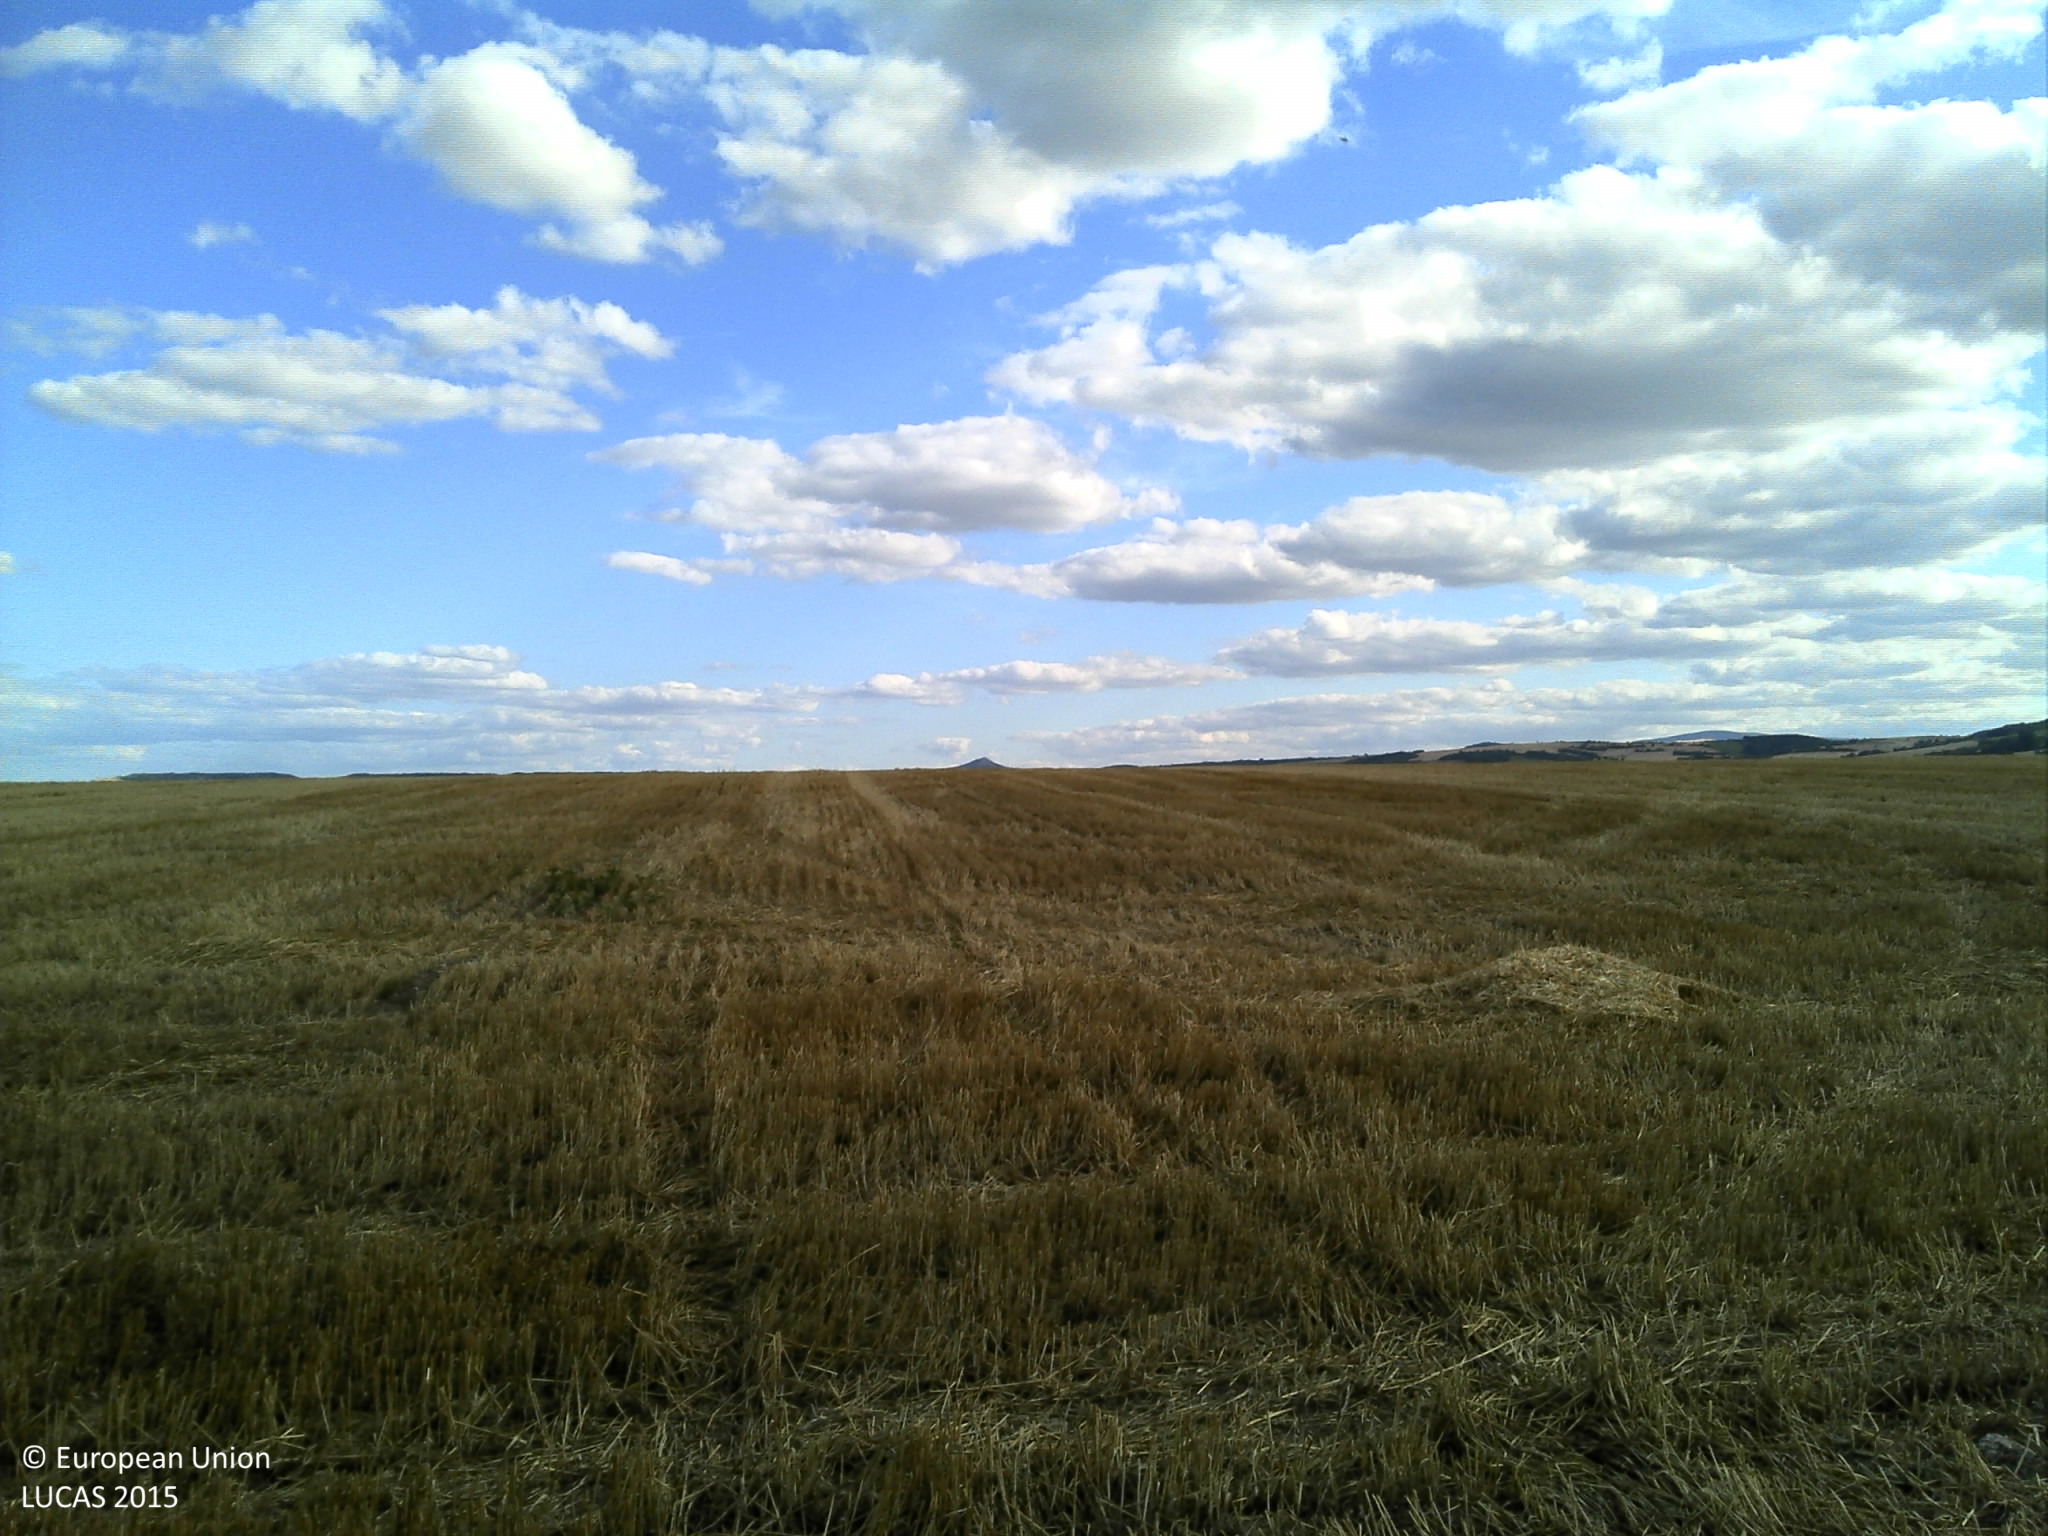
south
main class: Cropland
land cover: Common wheat
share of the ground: > 75 %
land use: Agriculture (excluding fallow land and kitchen gardens)
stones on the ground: 25 - 50 %
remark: Harvested field
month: July
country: FR
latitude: 45.6621
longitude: 3.1595
